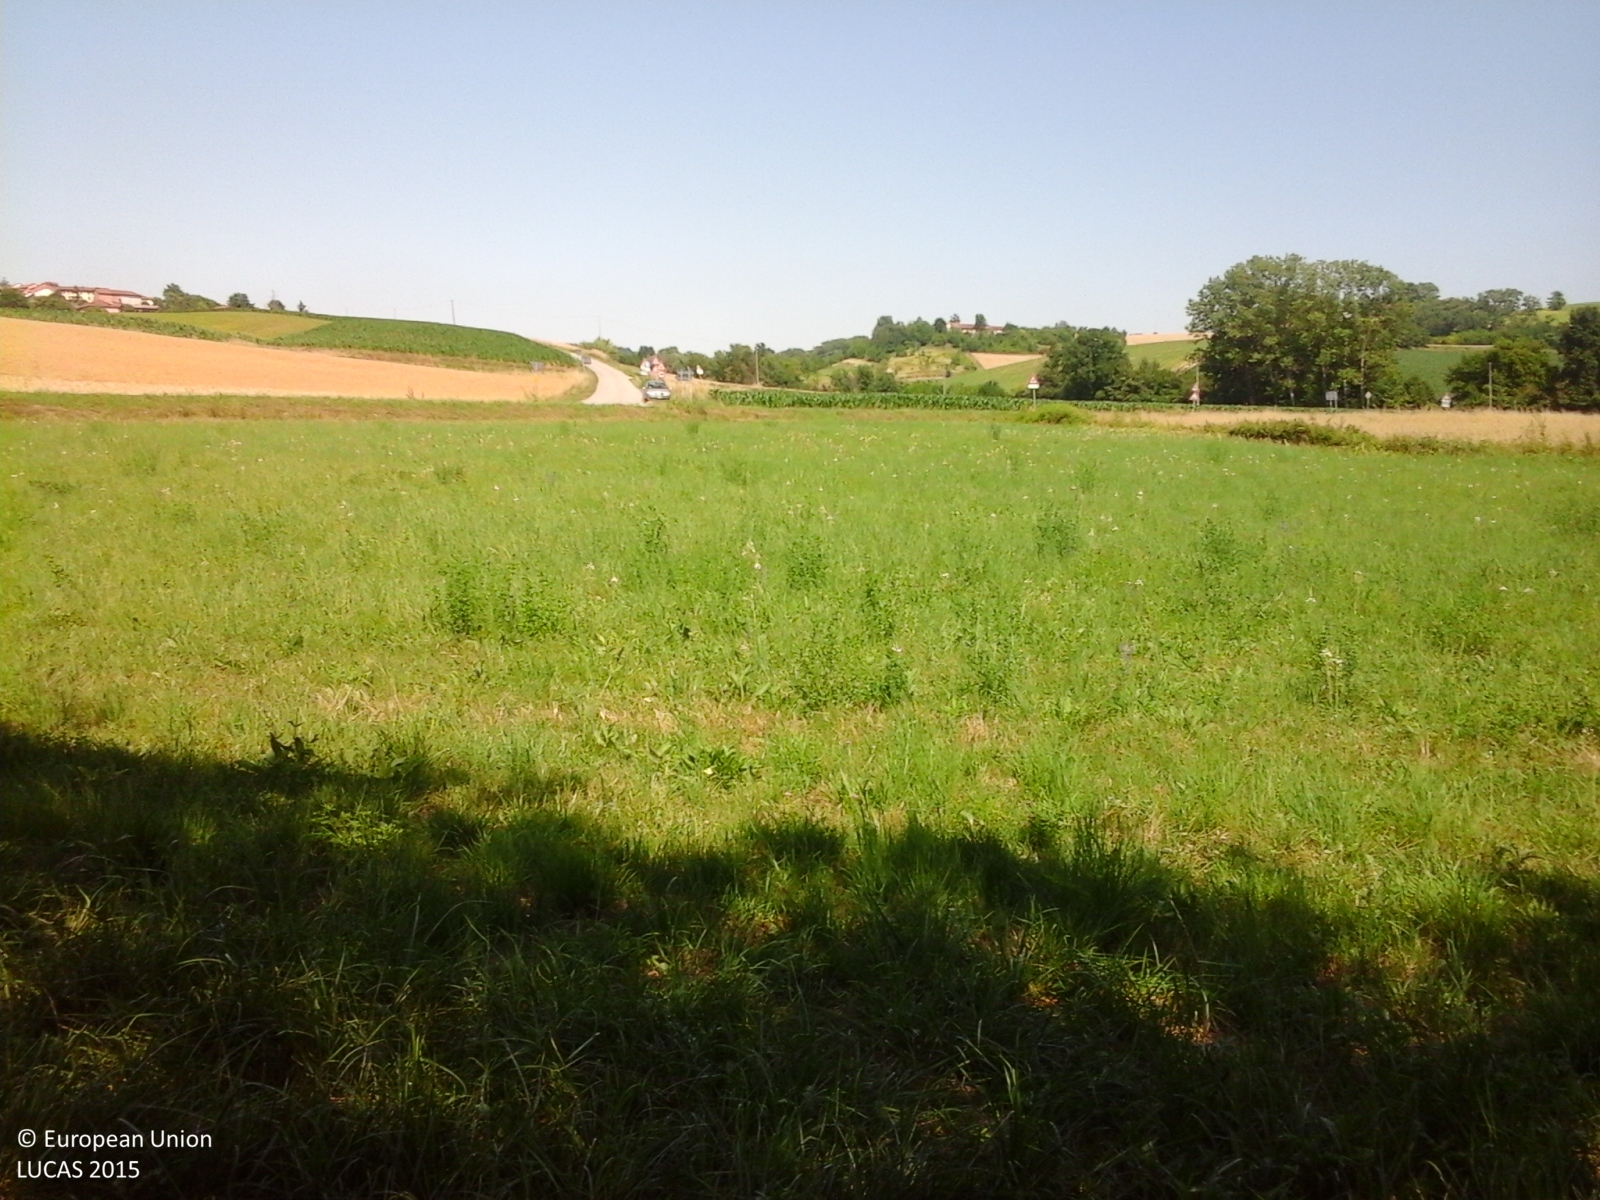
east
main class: Grassland
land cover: Grassland without tree/shrub cover
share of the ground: > 75 %
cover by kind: herbaceous plants 100 %
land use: Agriculture (excluding fallow land and kitchen gardens)
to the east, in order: Grassland without tree/shrub cover; Paved roads, cycling and walking lanes; Grass margins; Maize; Grass margins; Tracks; Grass margins; Maize
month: June
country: IT
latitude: 45.0025
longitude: 8.2145
